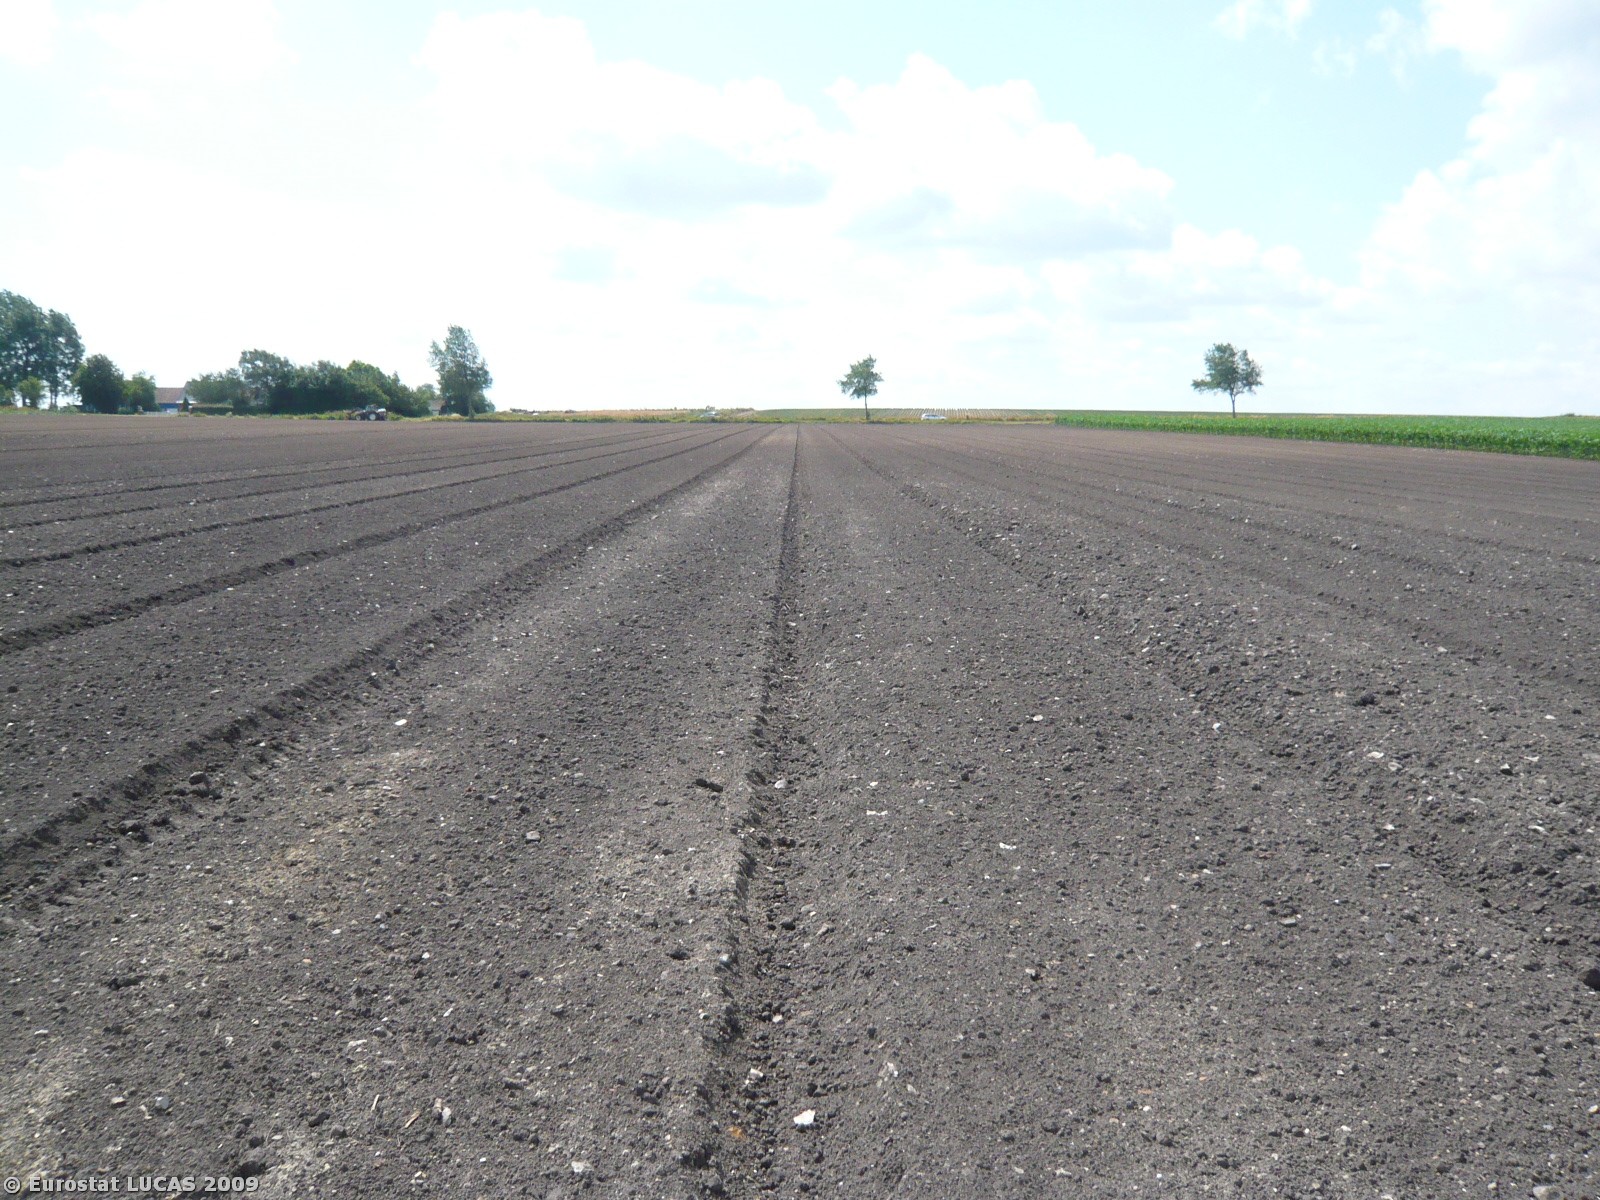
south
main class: Cropland
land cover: Other fresh vegetables
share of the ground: < 10 %
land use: Agriculture (excluding fallow land and kitchen gardens)
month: July
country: DK
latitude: 55.5943
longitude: 10.2695
